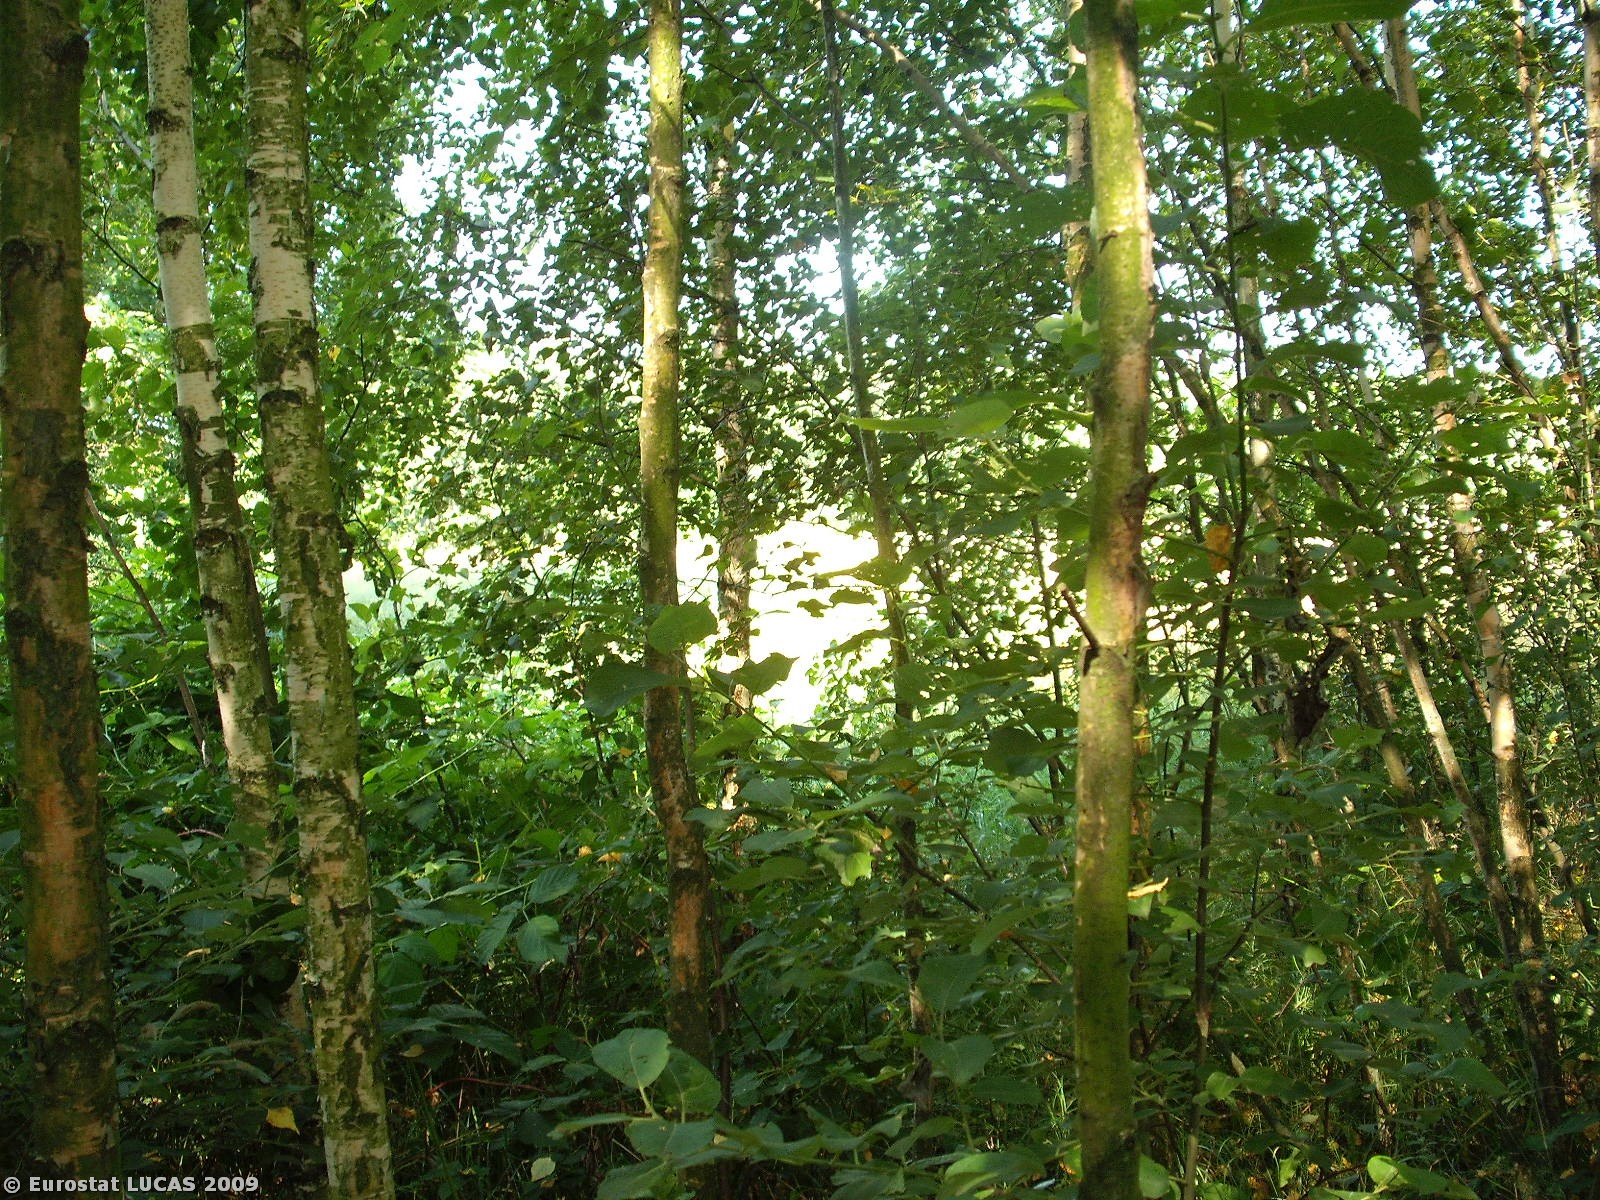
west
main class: Woodland
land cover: Broadleaved woodland
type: non-riverine alder, birch or aspen forest
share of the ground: > 75 %
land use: Forestry
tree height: > 5 m
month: July
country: PL
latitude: 51.9705
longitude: 21.5956
